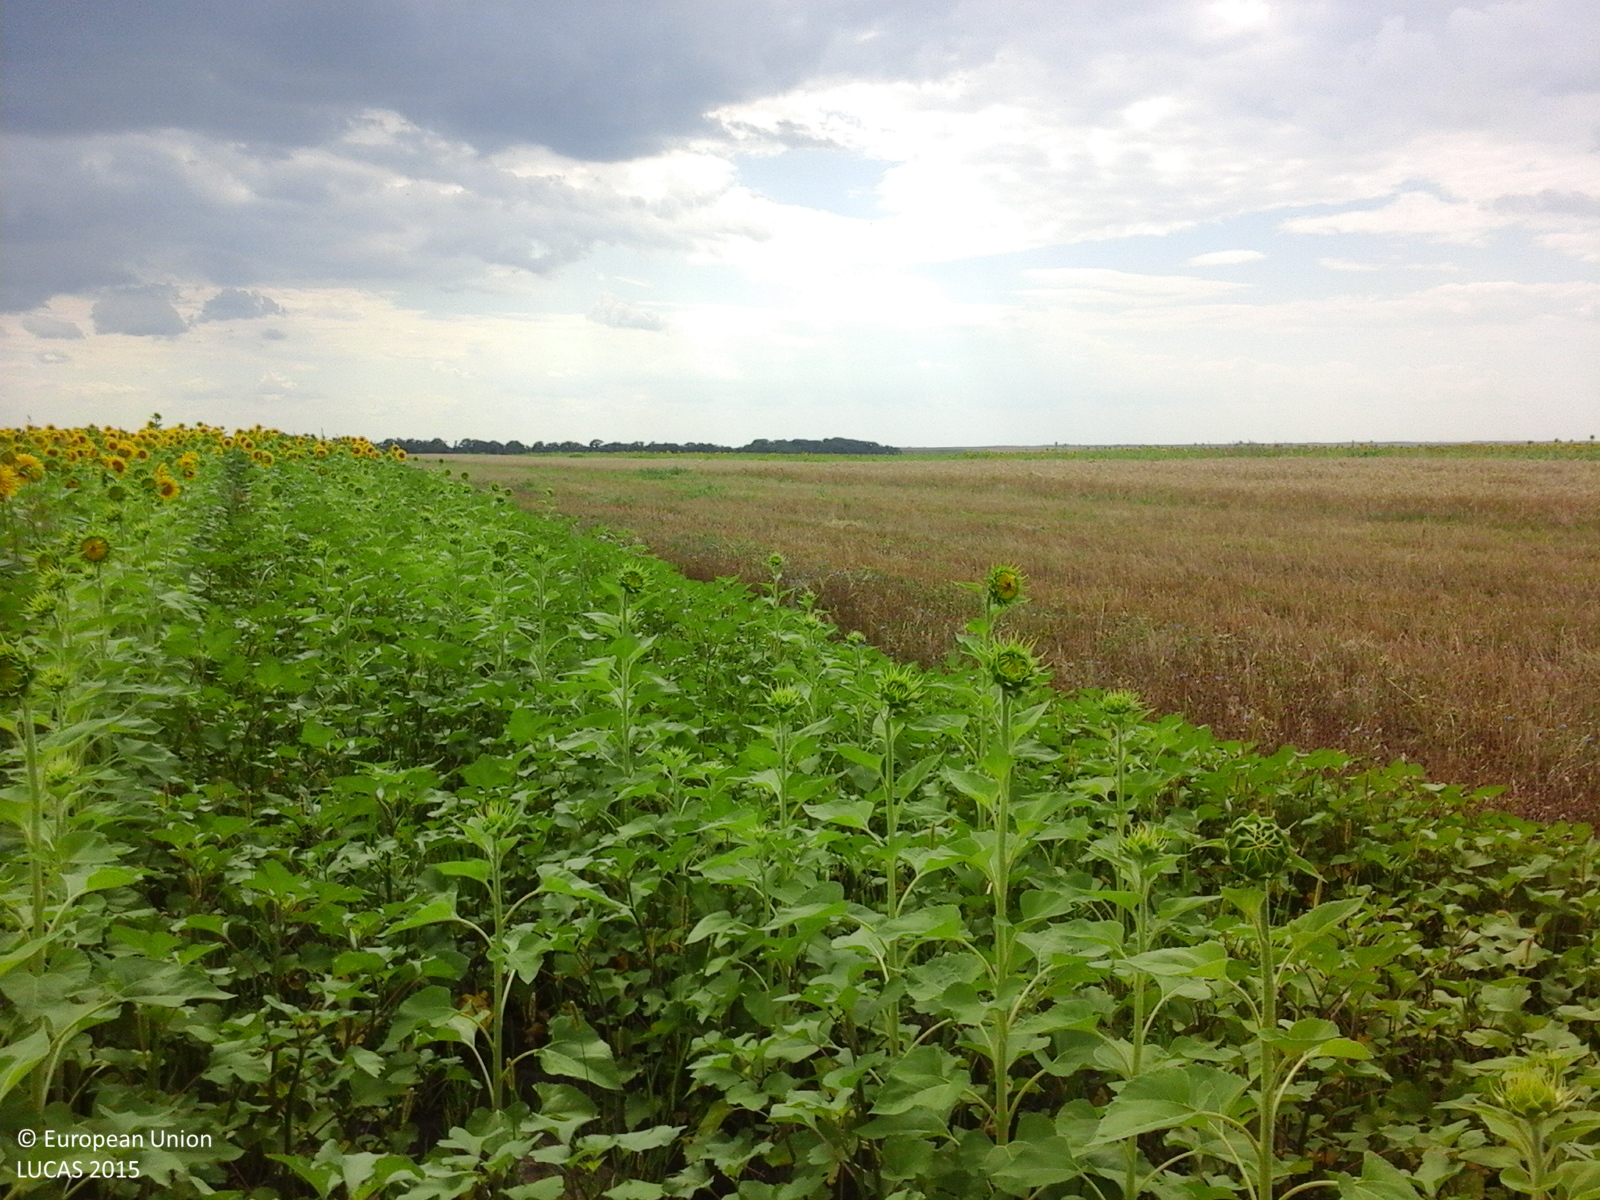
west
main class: Cropland
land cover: Sunflower
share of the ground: 25 - 50 %
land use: Agriculture (excluding fallow land and kitchen gardens)
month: July
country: RO
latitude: 44.0425
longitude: 24.7352
